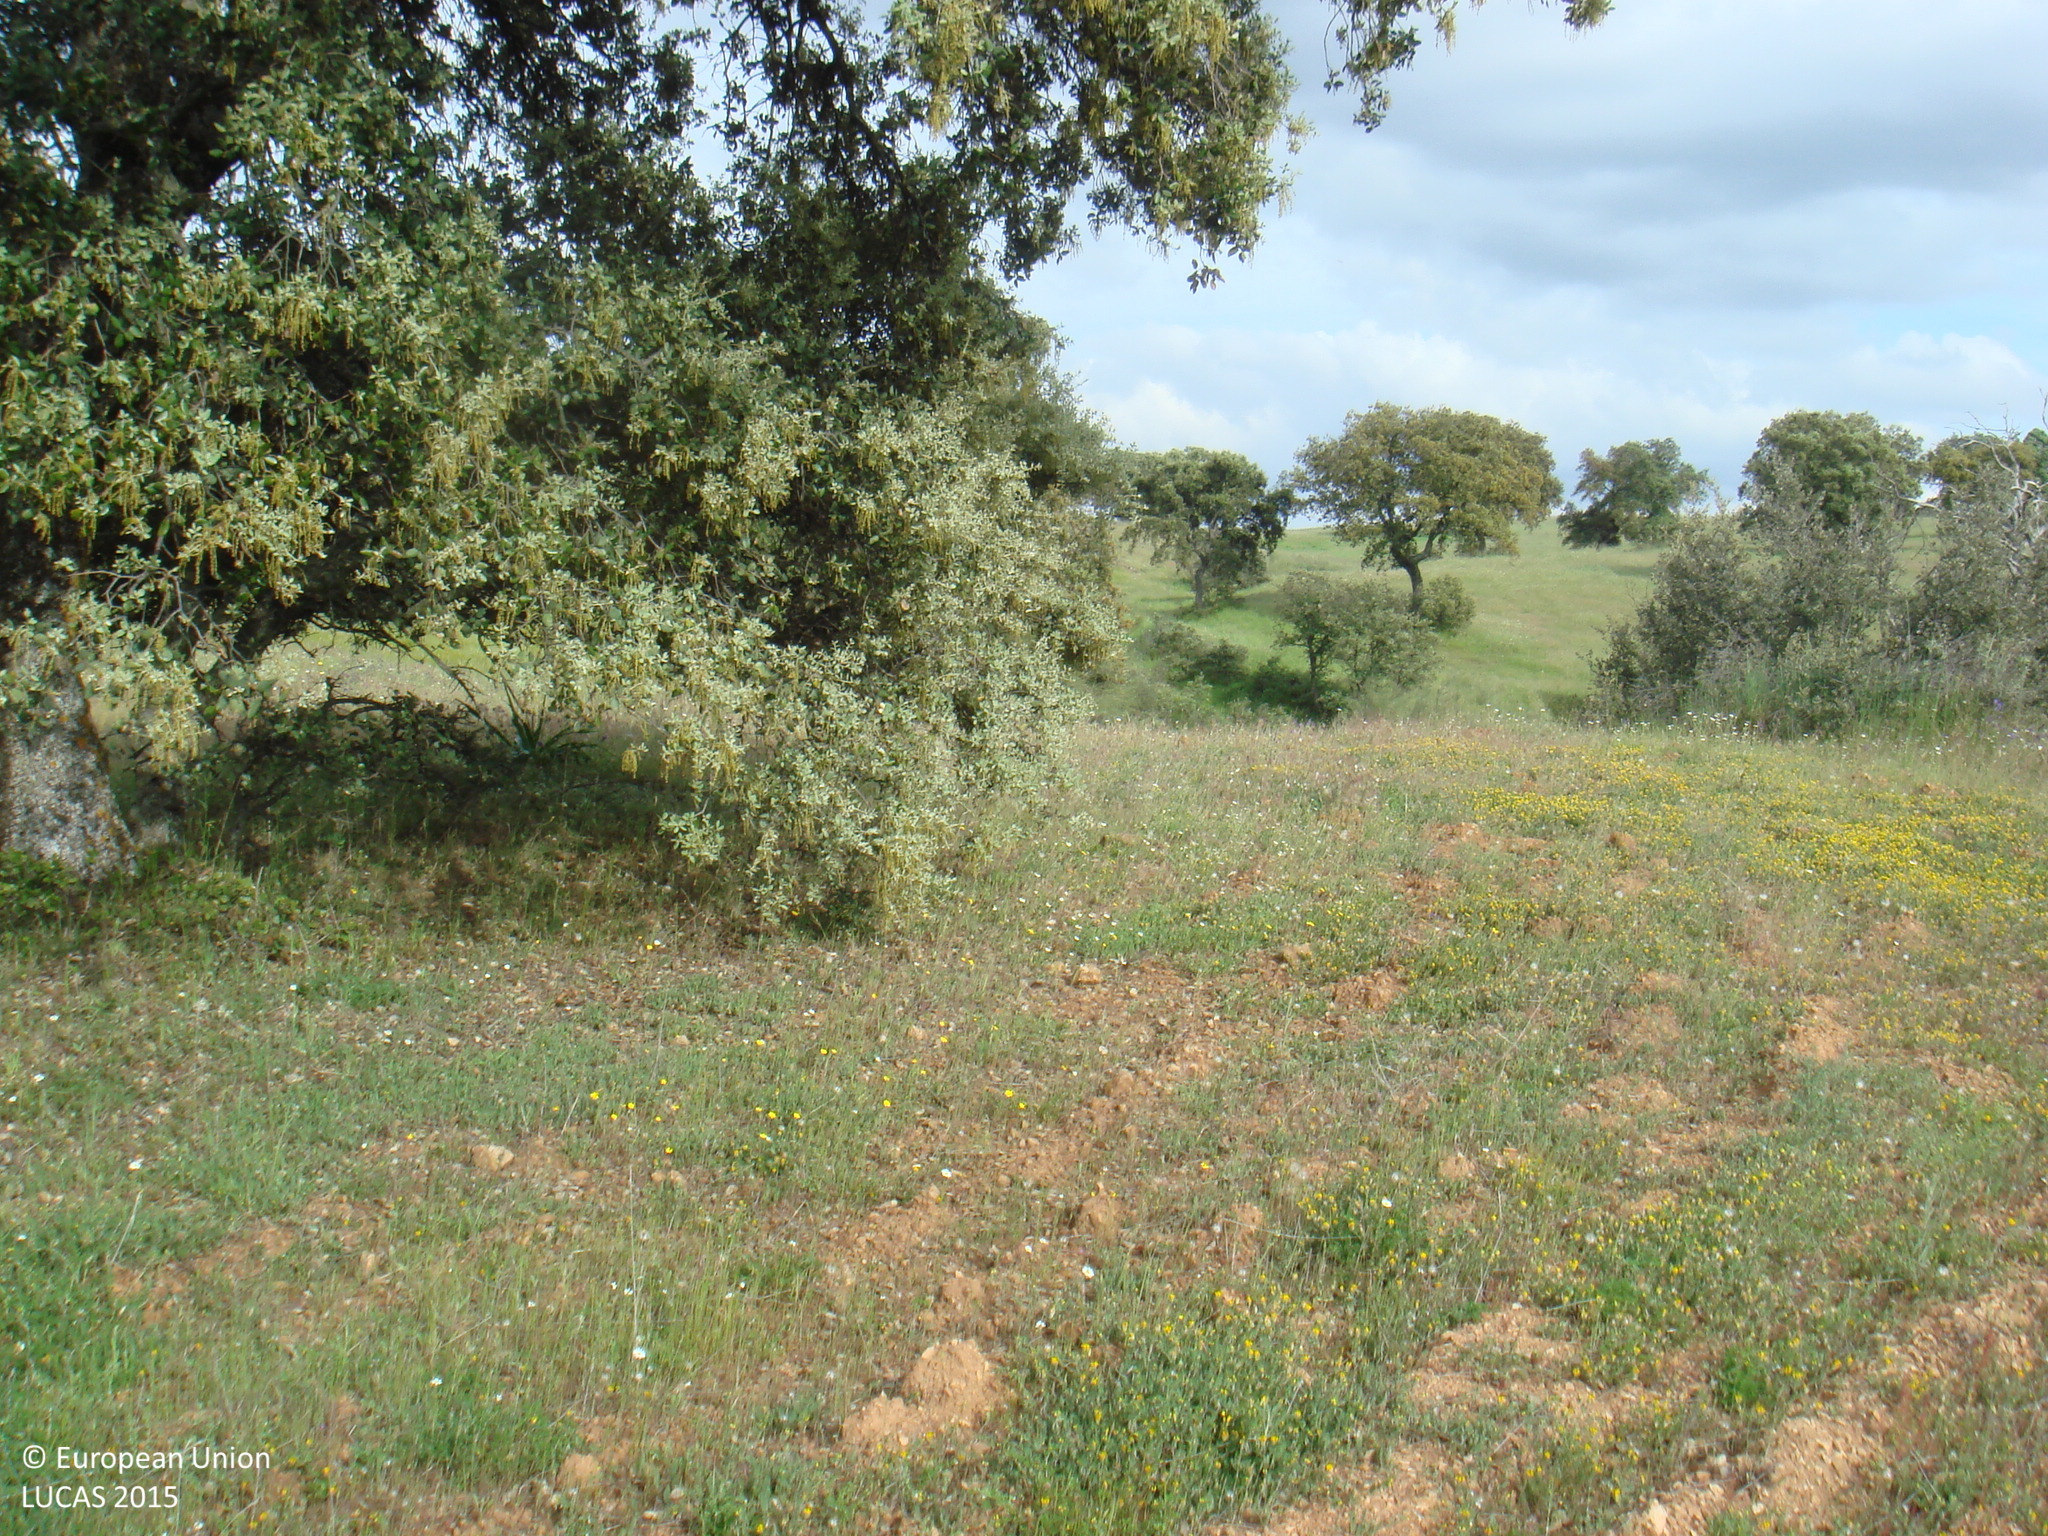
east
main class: Grassland
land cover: Grassland with sparse tree/shrub cover
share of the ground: > 75 %
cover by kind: herbaceous plants 50 %, unconsolidated bare surface 45 %, broadleaved forest trees 5 %
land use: Agriculture (excluding fallow land and kitchen gardens)
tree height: > 5 m
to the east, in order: Grassland with sparse tree/shrub cover; Broadleaved woodland; Grassland with sparse tree/shrub cover; Broadleaved woodland
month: April
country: ES
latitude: 38.1894
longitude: -4.9907
